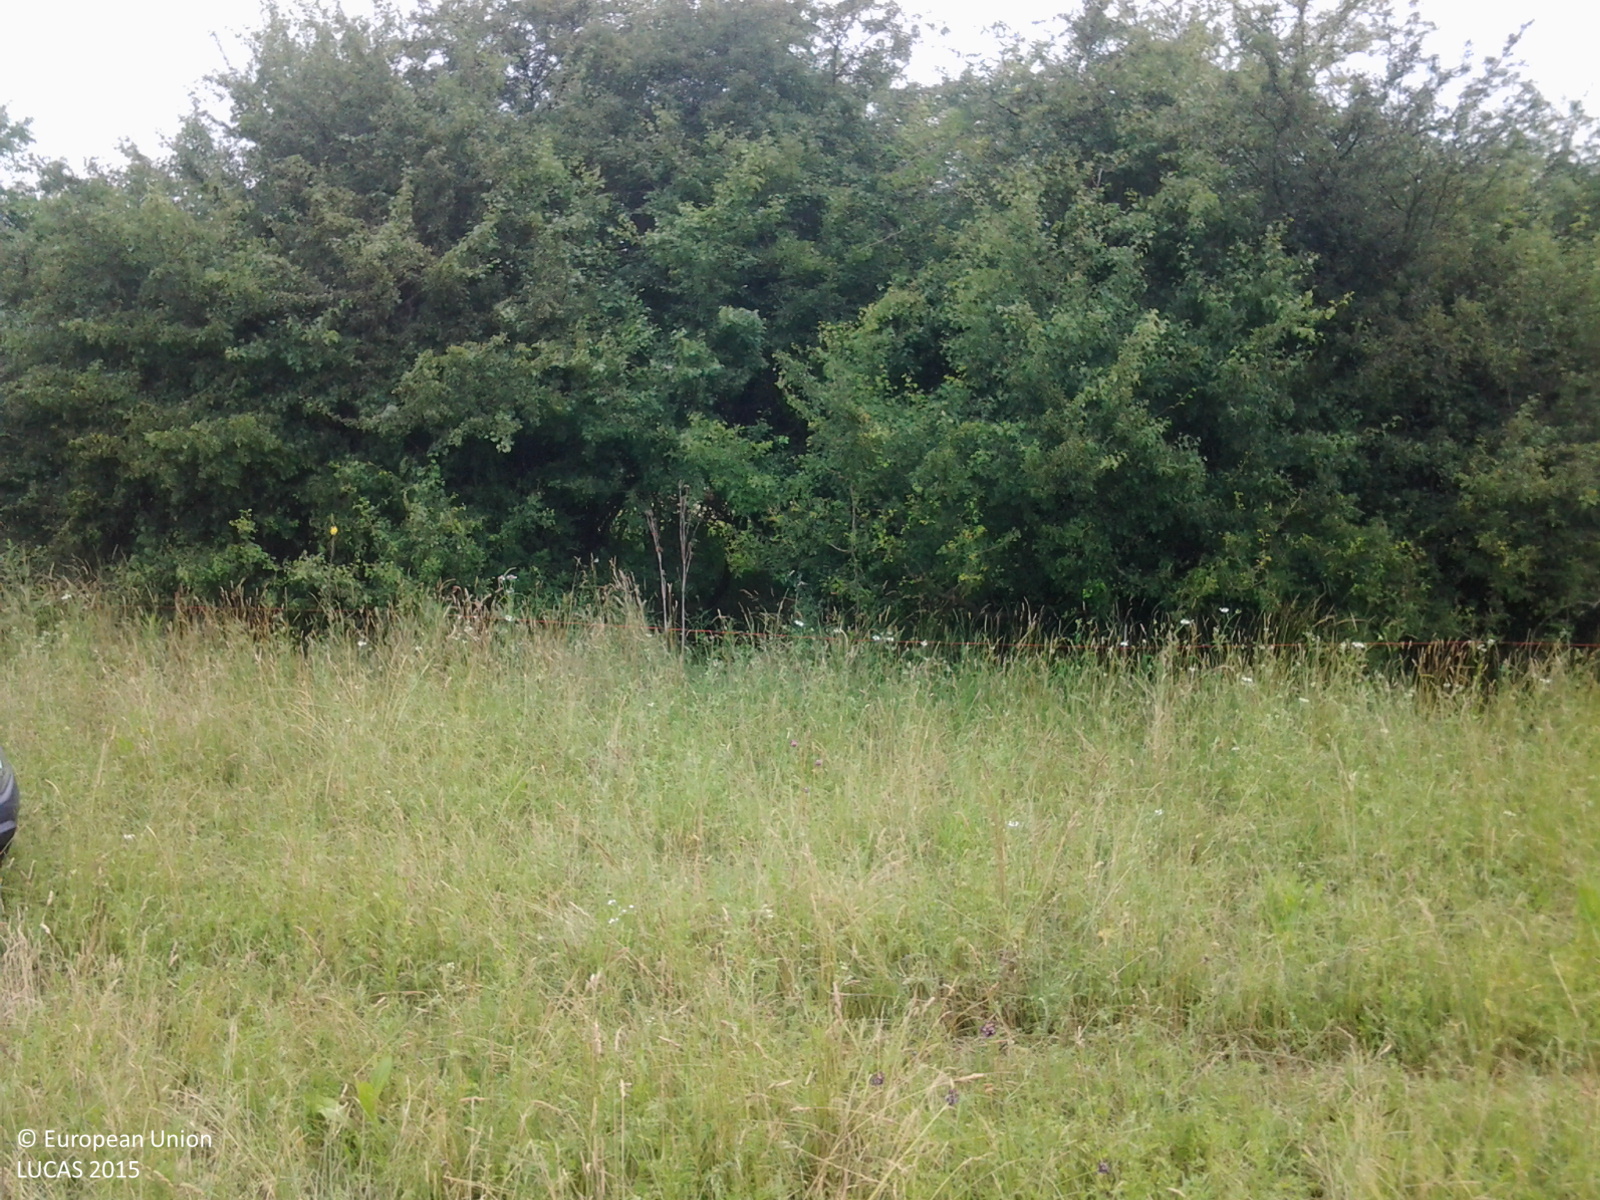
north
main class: Grassland
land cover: Grassland without tree/shrub cover
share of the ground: > 75 %
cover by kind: herbaceous plants 100 %
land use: Agriculture (excluding fallow land and kitchen gardens)
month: June
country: HU
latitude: 46.4819
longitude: 19.1720
